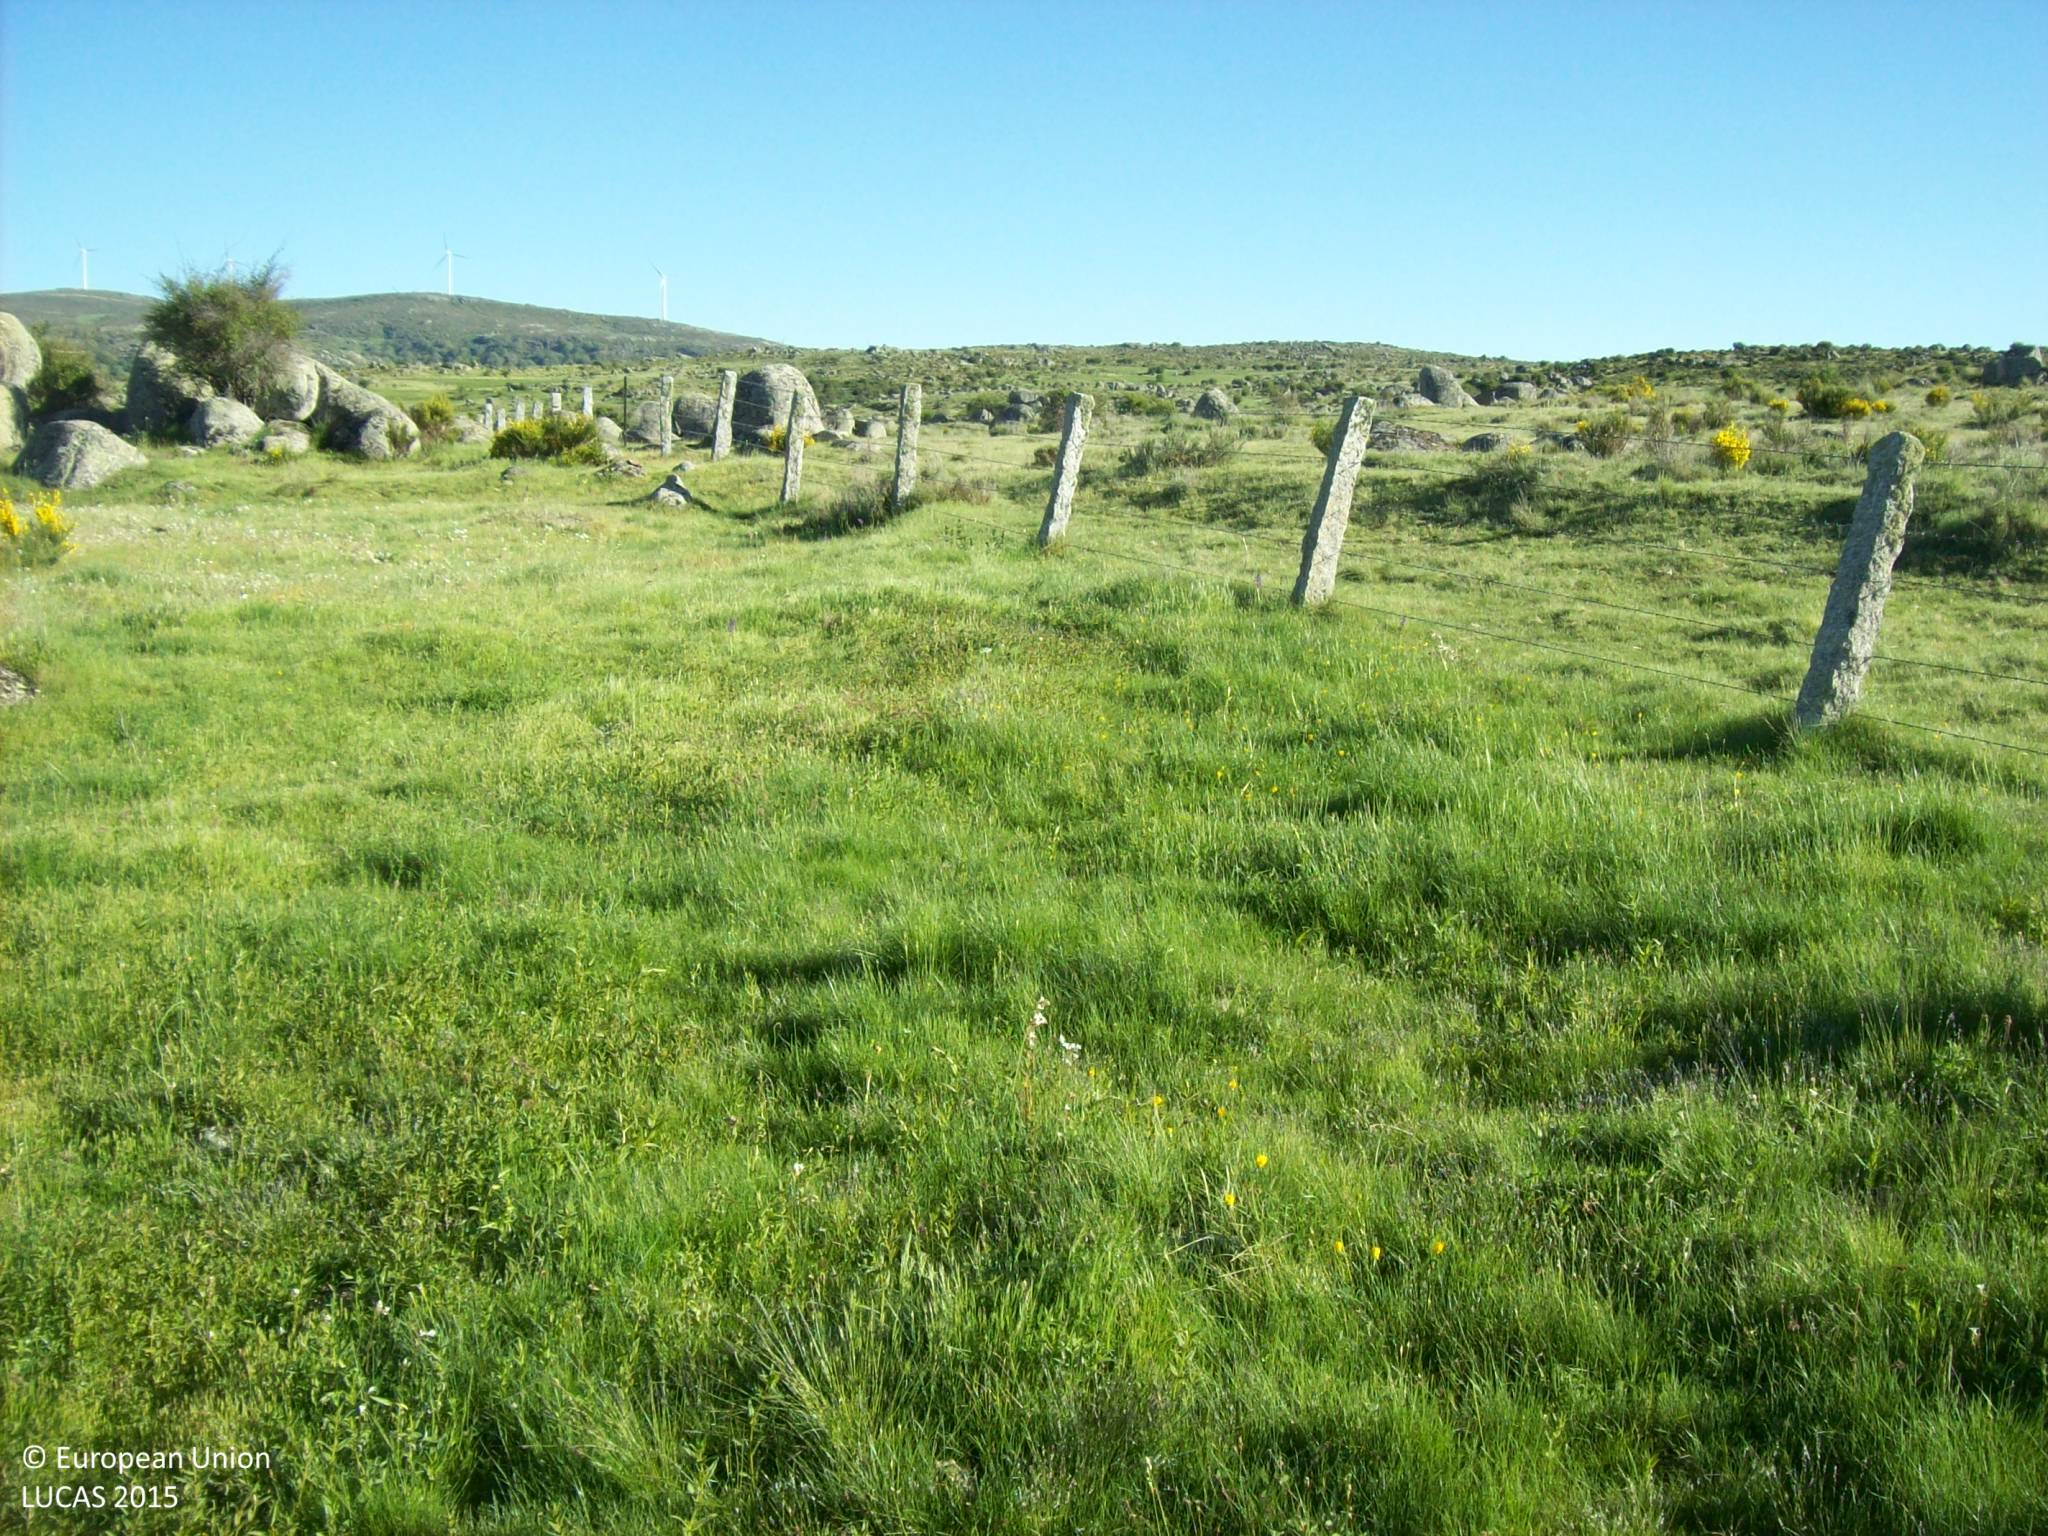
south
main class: Grassland
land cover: Grassland without tree/shrub cover
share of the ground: > 75 %
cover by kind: herbaceous plants 95 %, consolidated bare surface 5 %
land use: Agriculture (excluding fallow land and kitchen gardens)
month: May
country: ES
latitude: 40.6530
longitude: -5.0939
